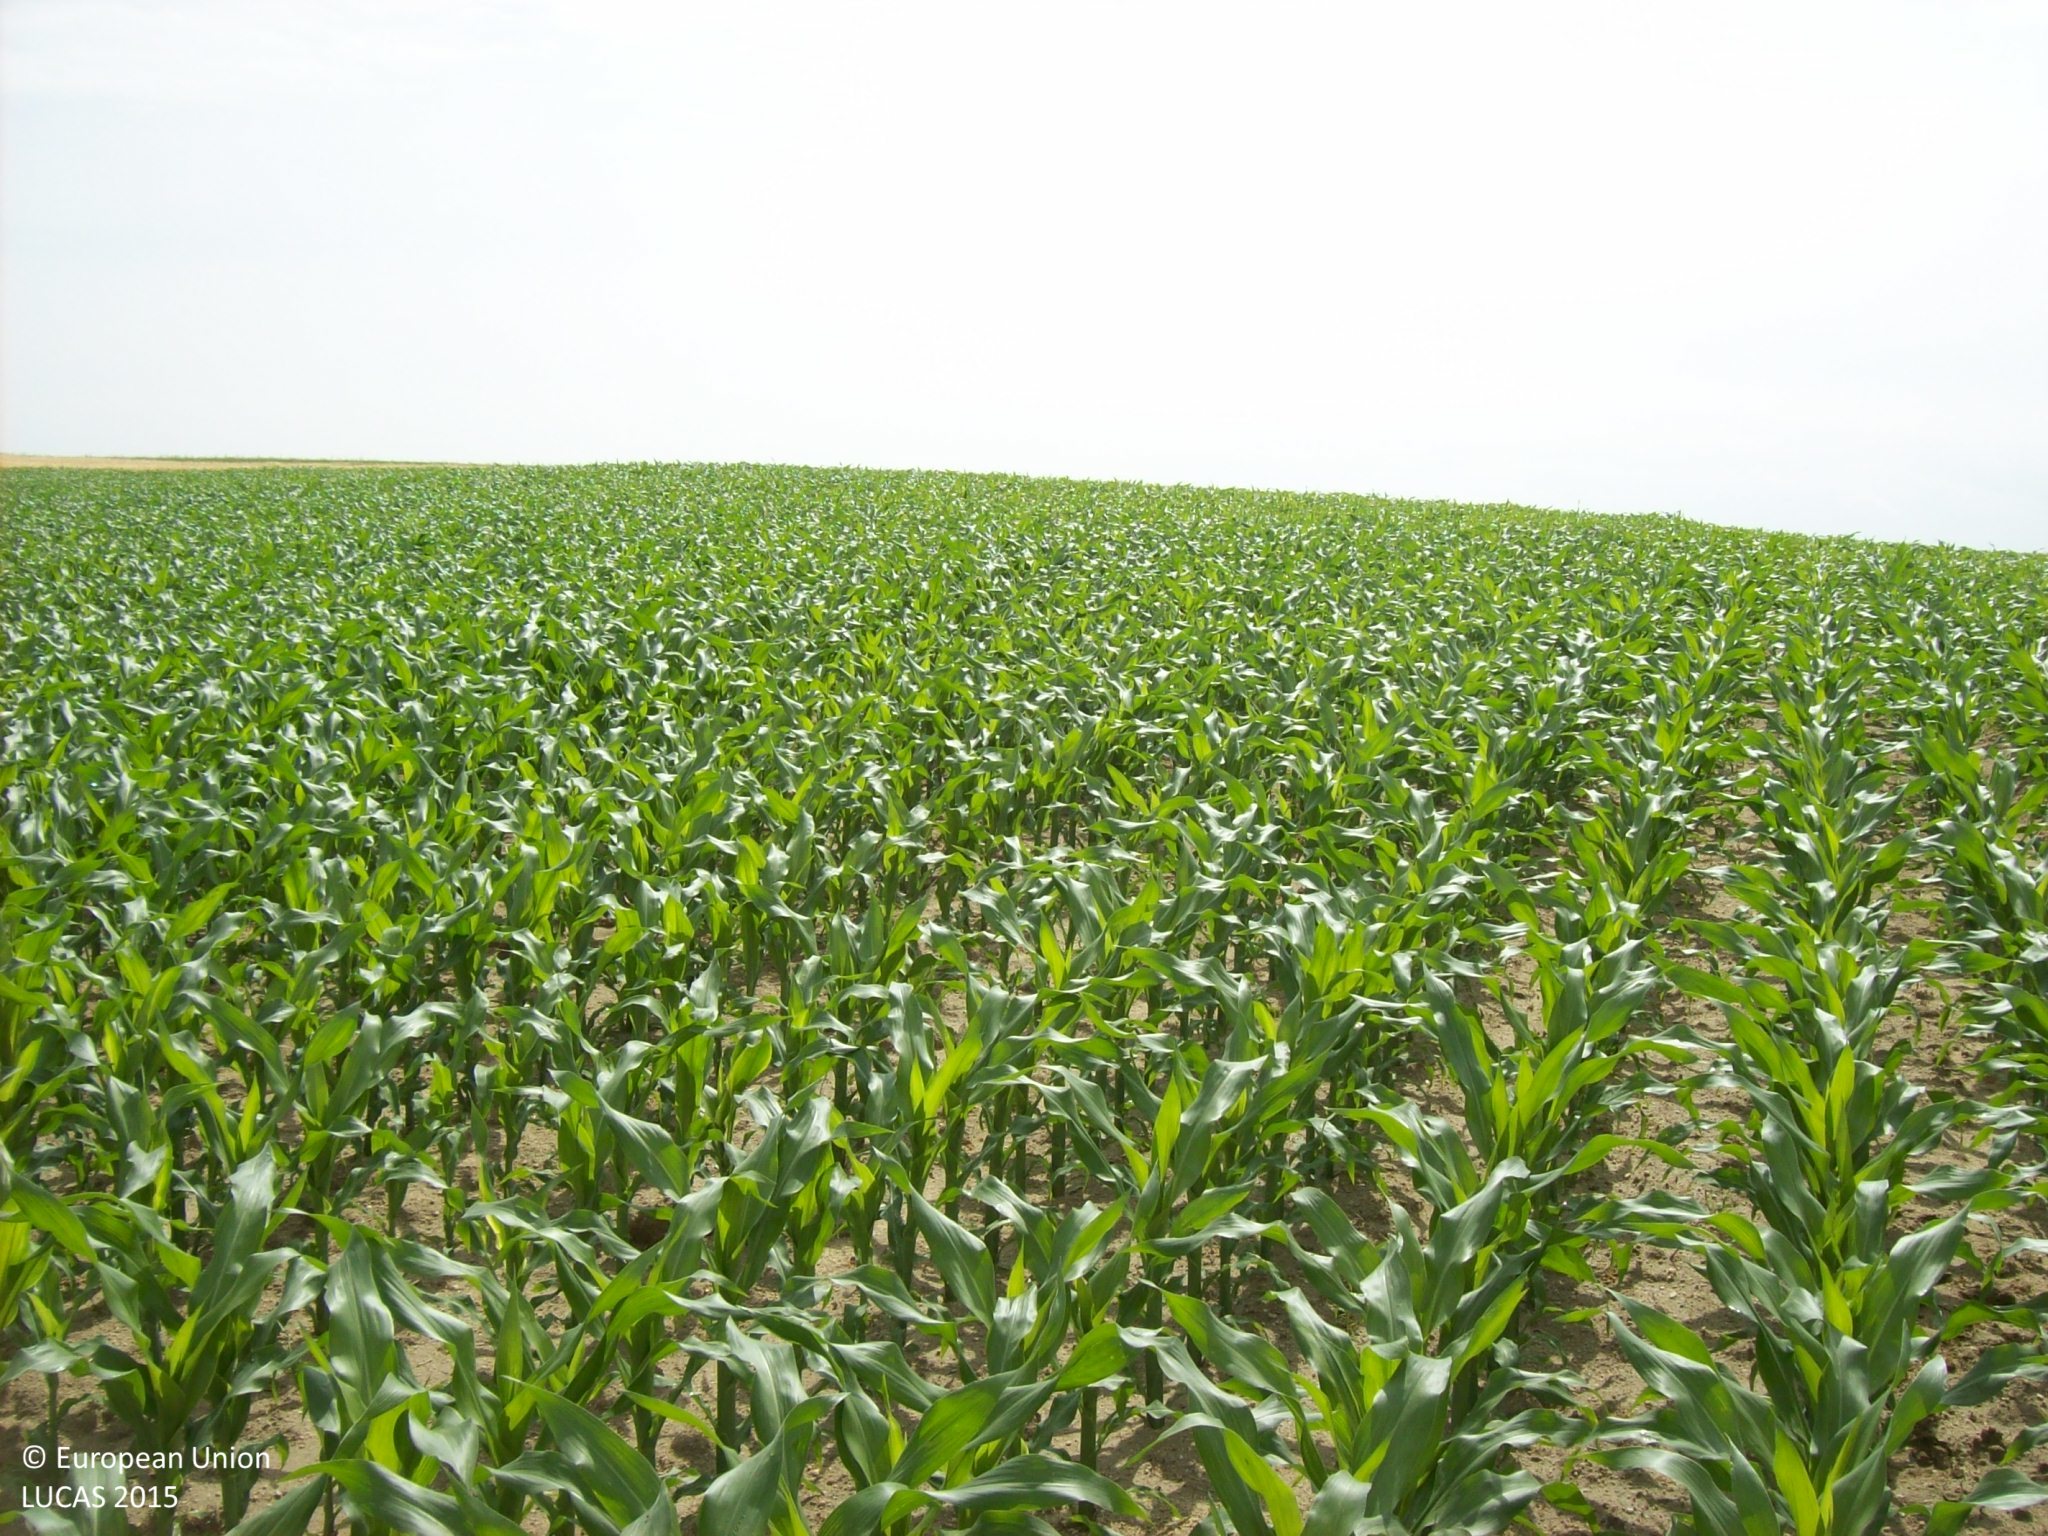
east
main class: Cropland
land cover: Maize
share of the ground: > 75 %
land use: Agriculture (excluding fallow land and kitchen gardens)
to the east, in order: Maize; Grass margins; Barley; Grass margins; Lucerne
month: June
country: ES
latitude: 40.9964
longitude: -5.0085
